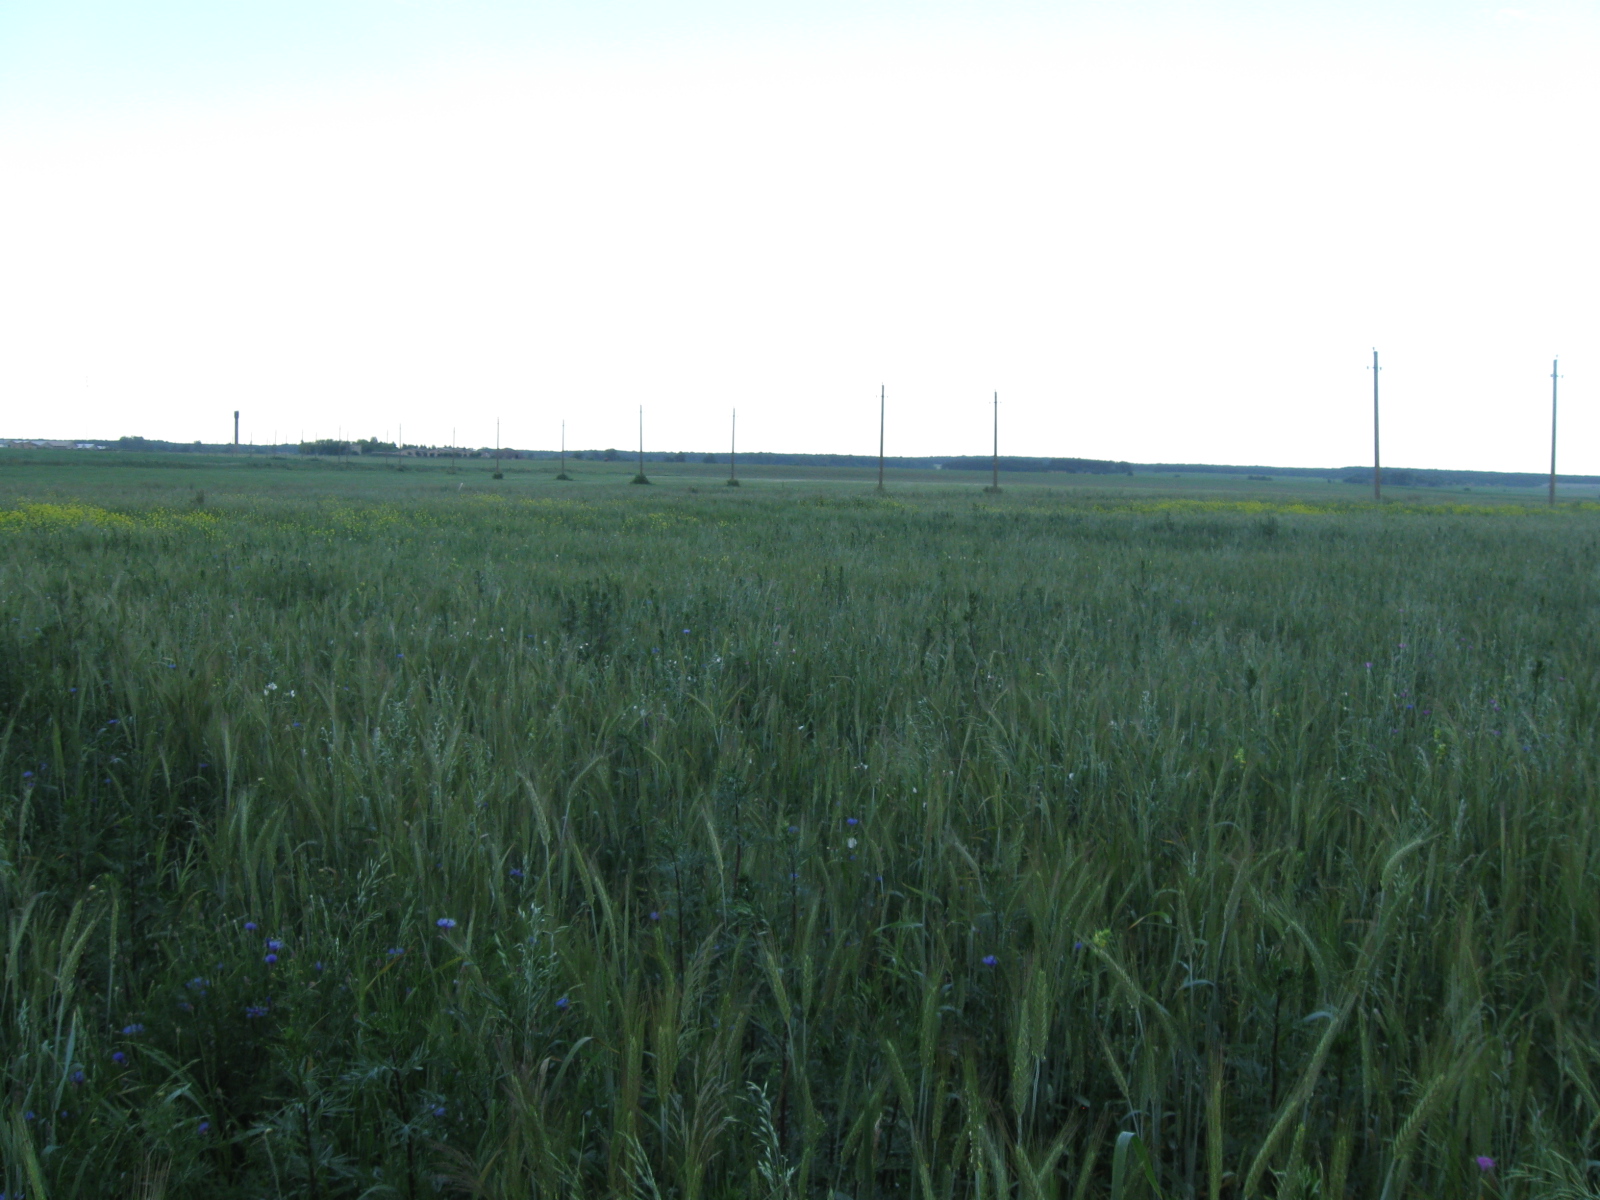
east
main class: Cropland
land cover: Temporary grasslands
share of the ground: > 75 %
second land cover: Triticale
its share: 10 - 25 %
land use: Agriculture (excluding fallow land and kitchen gardens)
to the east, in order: Temporary grasslands; Triticale; Spontaneously vegetated surfaces; Ditches and canals; Spontaneously vegetated surfaces; Grassland without tree/shrub cover; Electric lines; Grassland without tree/shrub cover
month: June
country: LT
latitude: 54.1376
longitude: 24.7578
